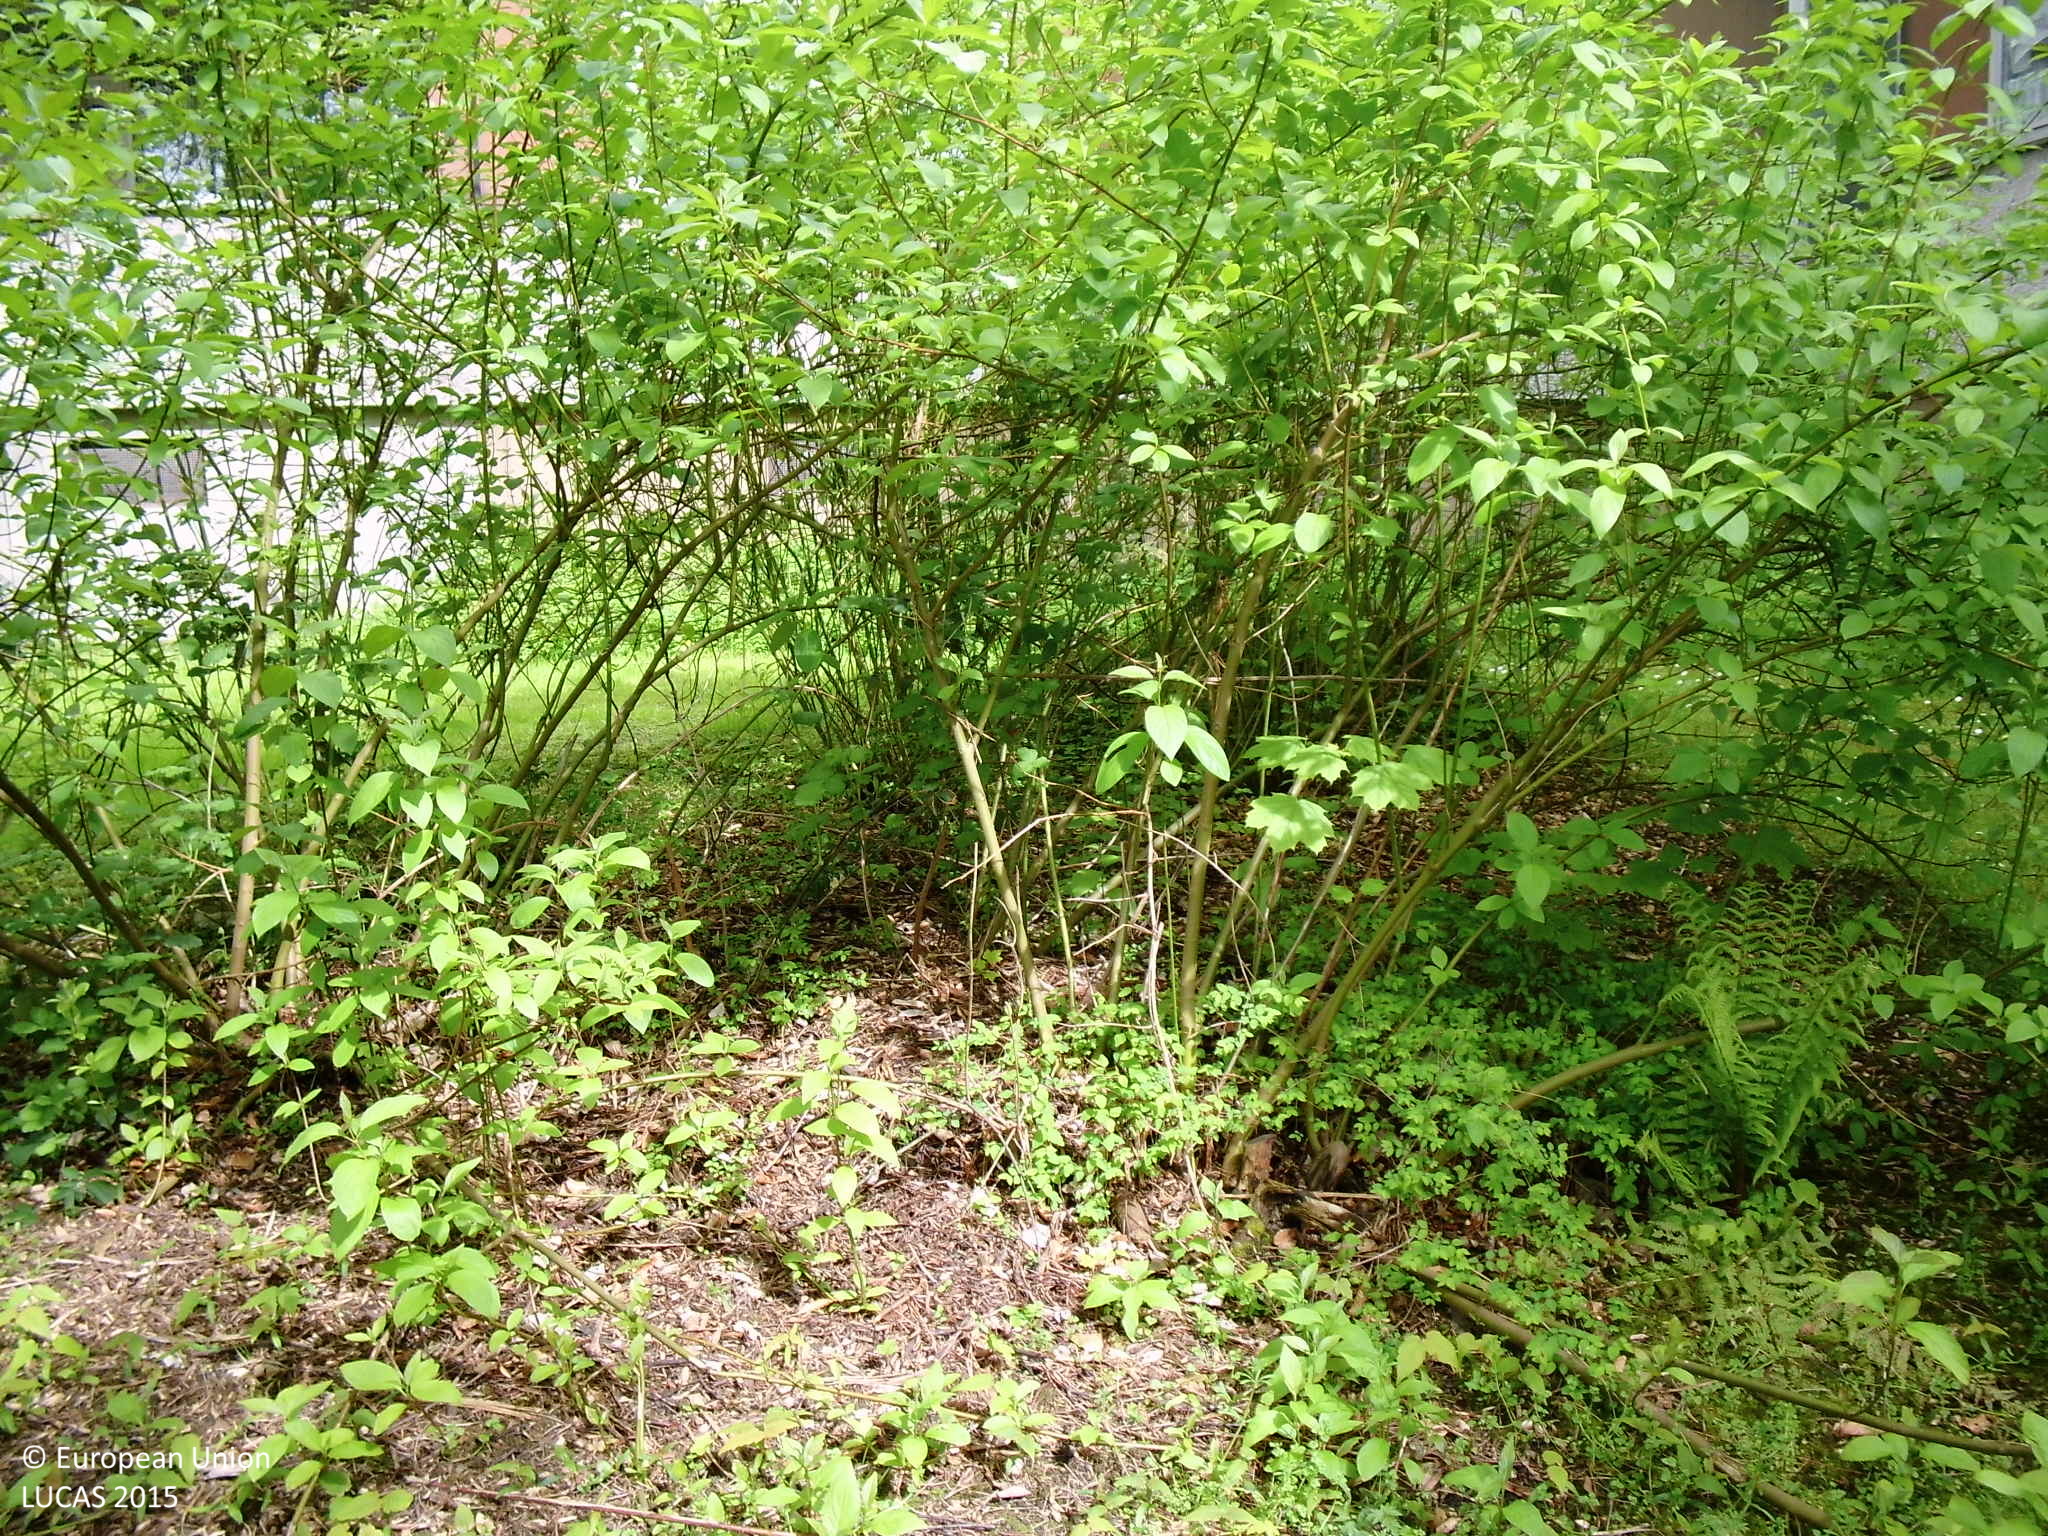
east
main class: Woodland
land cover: Broadleaved woodland
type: mesophytic deciduous forest
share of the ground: > 75 %
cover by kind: broadleaved forest trees 75 %, shrubs 10 %, herbaceous plants 10 %, unconsolidated bare surface 5 %
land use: Residential
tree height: > 5 m
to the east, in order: Broadleaved woodland; Artificial constructions in urban areas
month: May
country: DE
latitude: 51.5575
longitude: 7.3895
